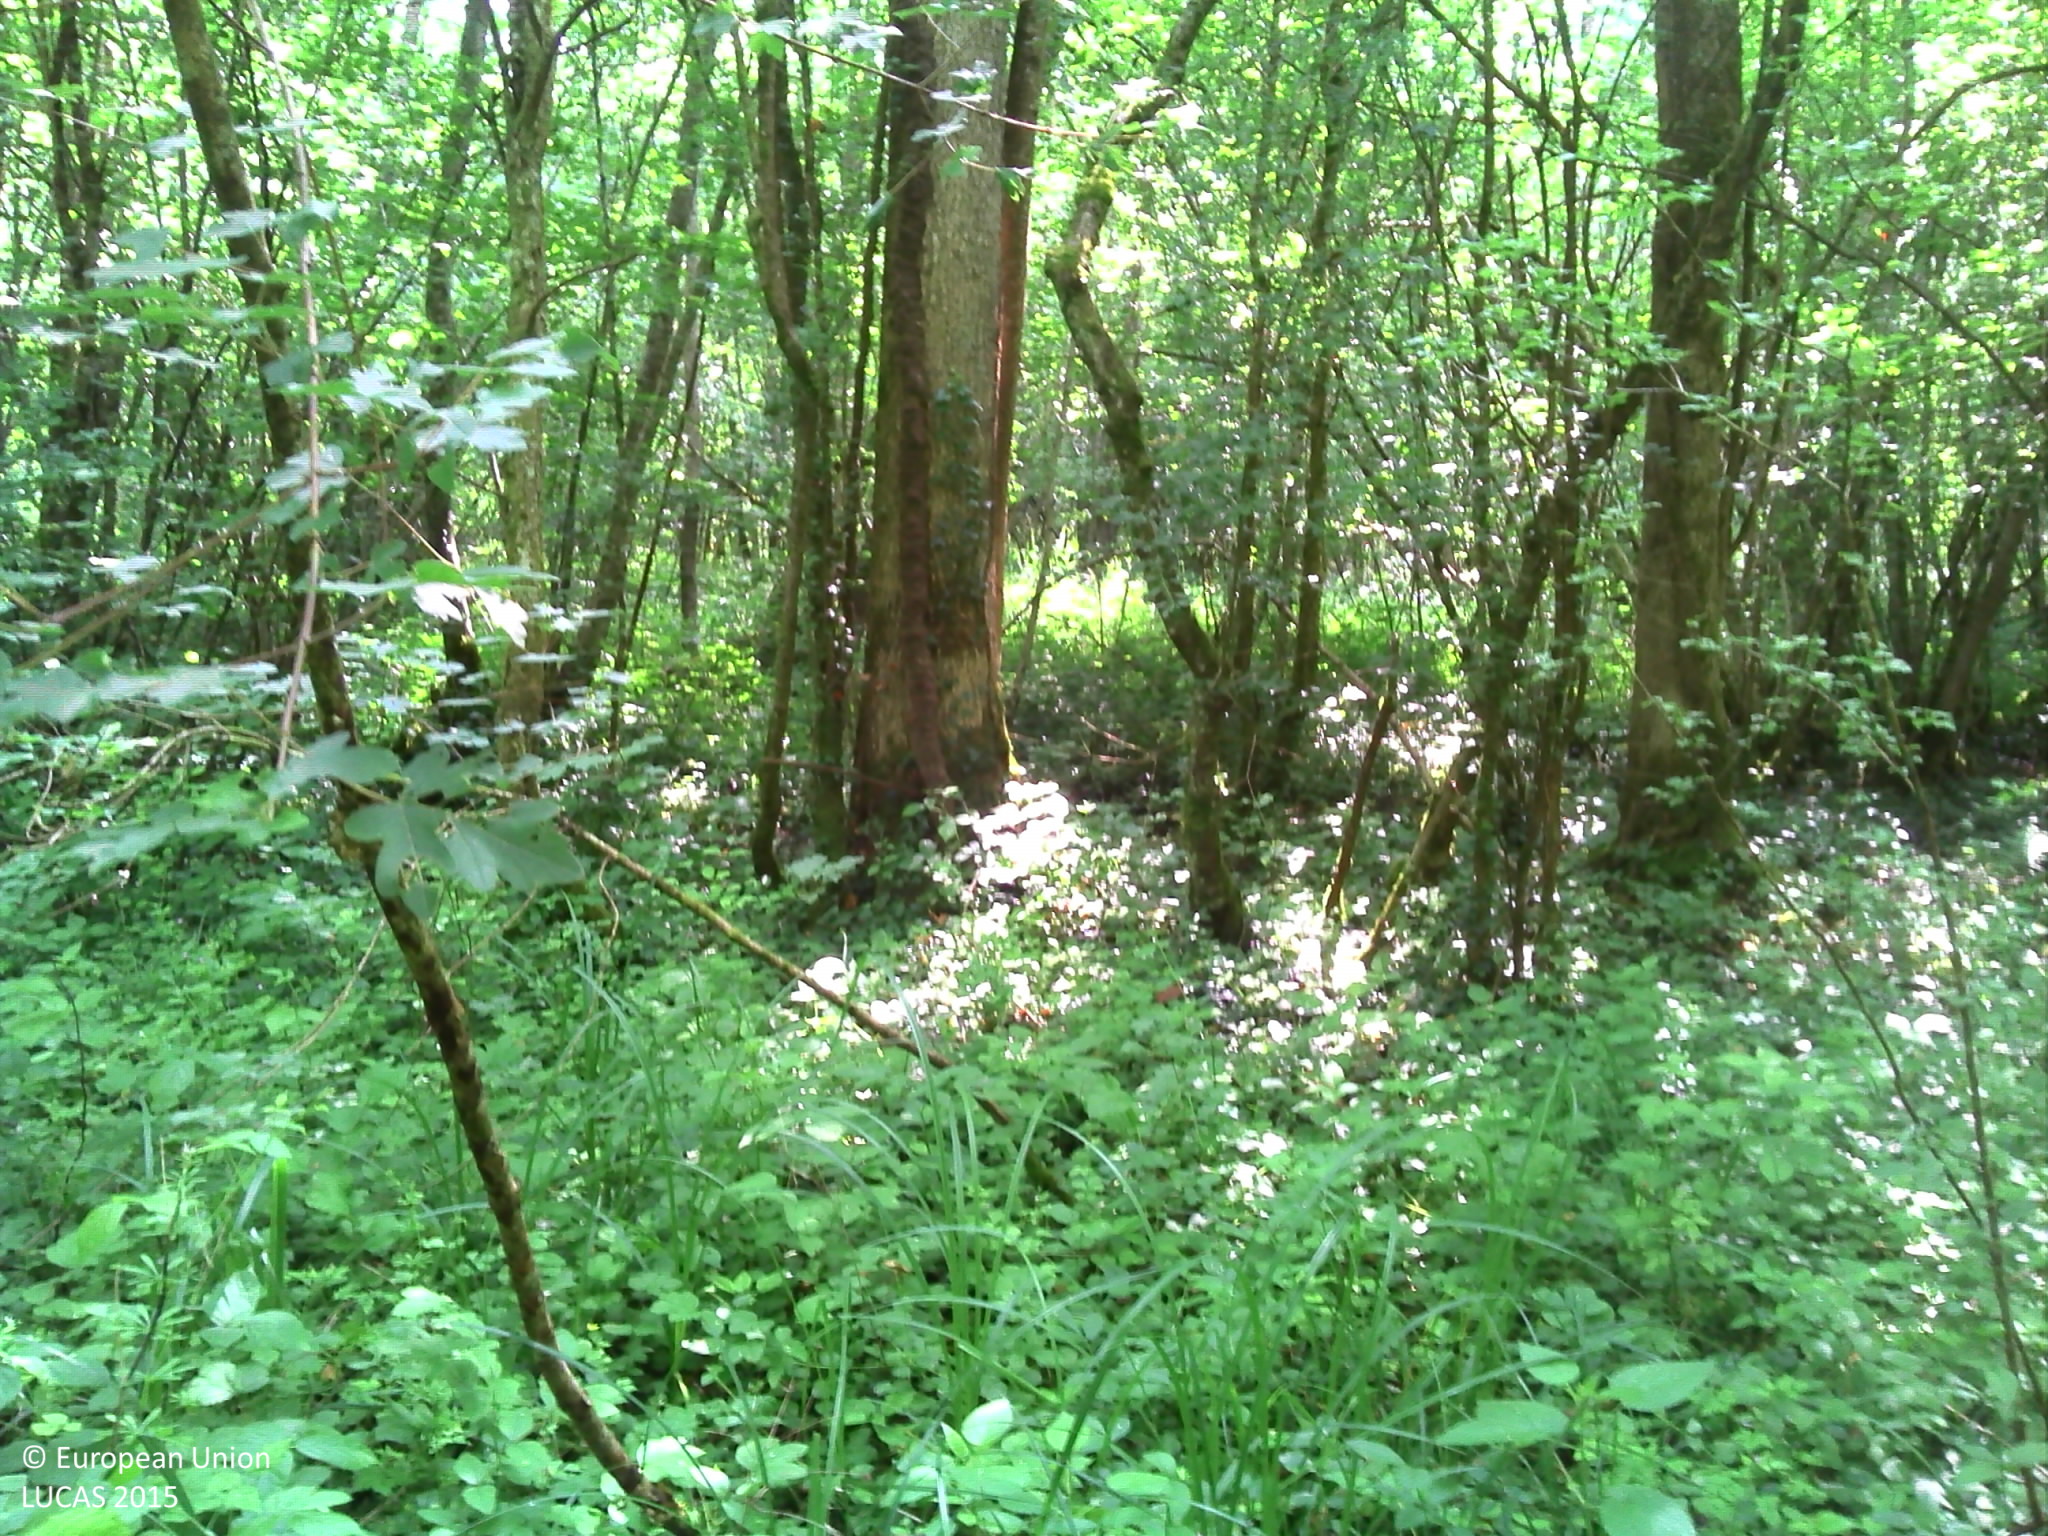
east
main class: Woodland
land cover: Broadleaved woodland
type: beech forest
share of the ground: > 75 %
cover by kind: broadleaved forest trees 90 %, herbaceous plants 10 %
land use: Forestry
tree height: > 5 m
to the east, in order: Broadleaved woodland; Tracks; Broadleaved woodland; Ditches and canals; Broadleaved woodland; Rivers and streams; Broadleaved woodland; Rivers and streams; Broadleaved woodland; Inland marshes; Broadleaved woodland; Shrubland without tree cover; Spruce dominated mixed woodland; Tracks; Spruce dominated mixed woodland; Temporary grasslands; Broadleaved woodland
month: June
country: FR
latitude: 47.9045
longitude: 6.1614
